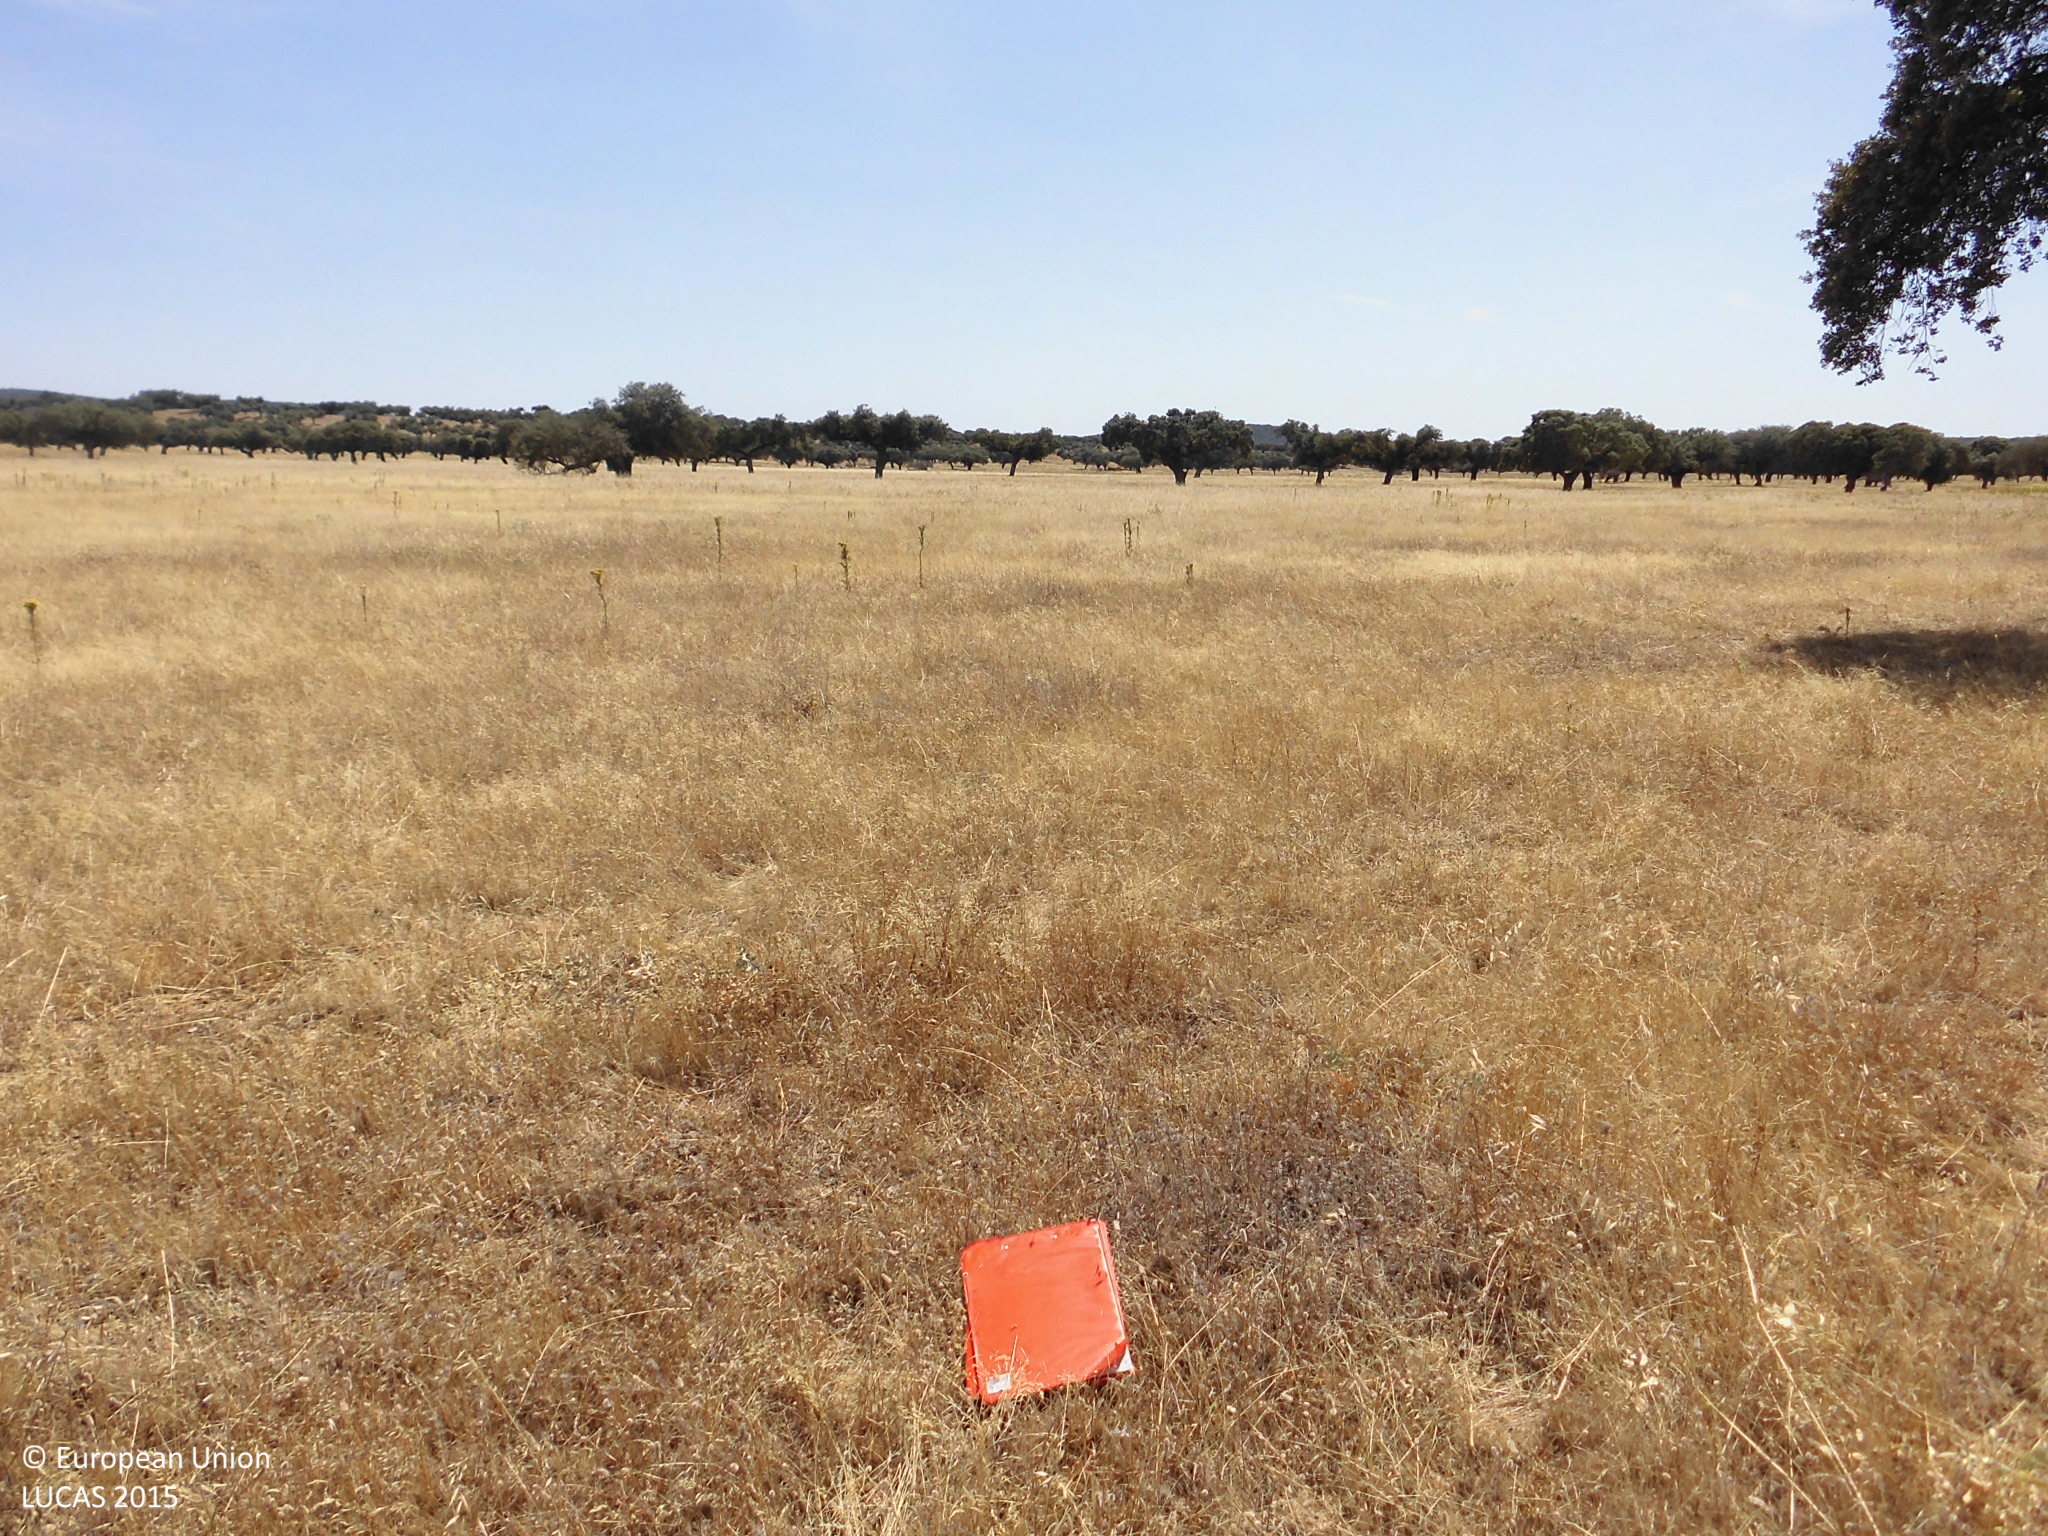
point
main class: Woodland
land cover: Broadleaved woodland
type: broadleaved evergreen forest
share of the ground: 10 - 25 %
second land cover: Grassland without tree/shrub cover
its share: > 75 %
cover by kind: herbaceous plants 90 %, broadleaved forest trees 10 %
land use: Forestry
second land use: Agriculture (excluding fallow land and kitchen gardens)
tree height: > 5 m
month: July
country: ES
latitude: 39.8817
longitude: -6.5542
